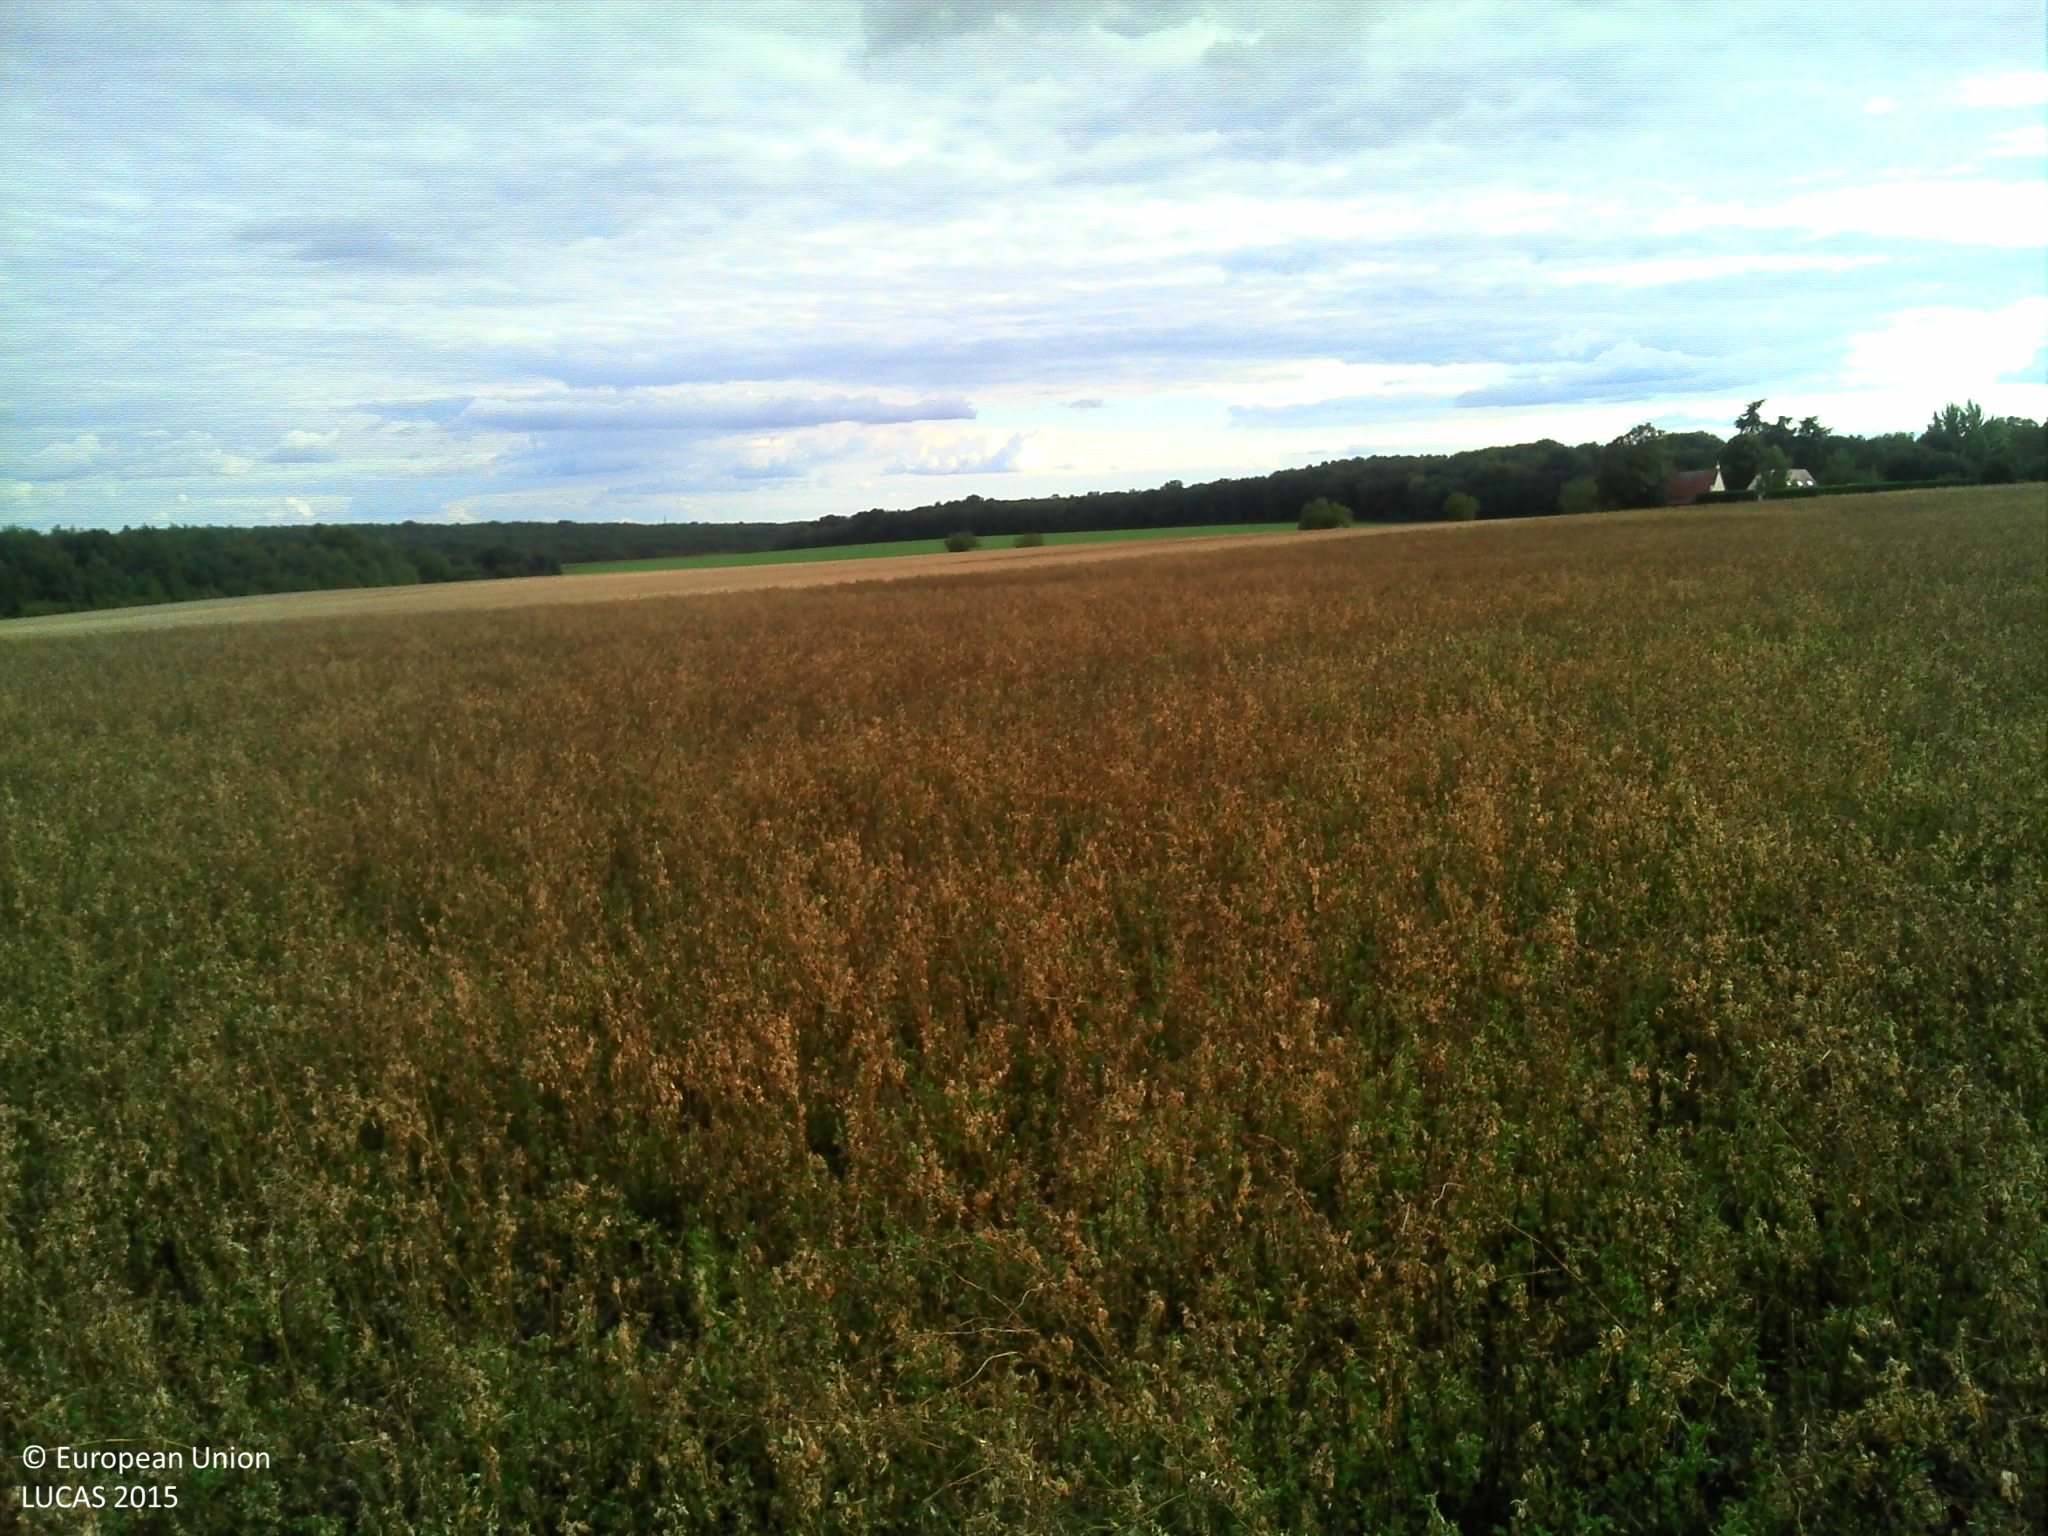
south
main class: Cropland
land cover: Lucerne
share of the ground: > 75 %
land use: Agriculture (excluding fallow land and kitchen gardens)
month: September
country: FR
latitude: 46.8833
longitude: 1.5243
